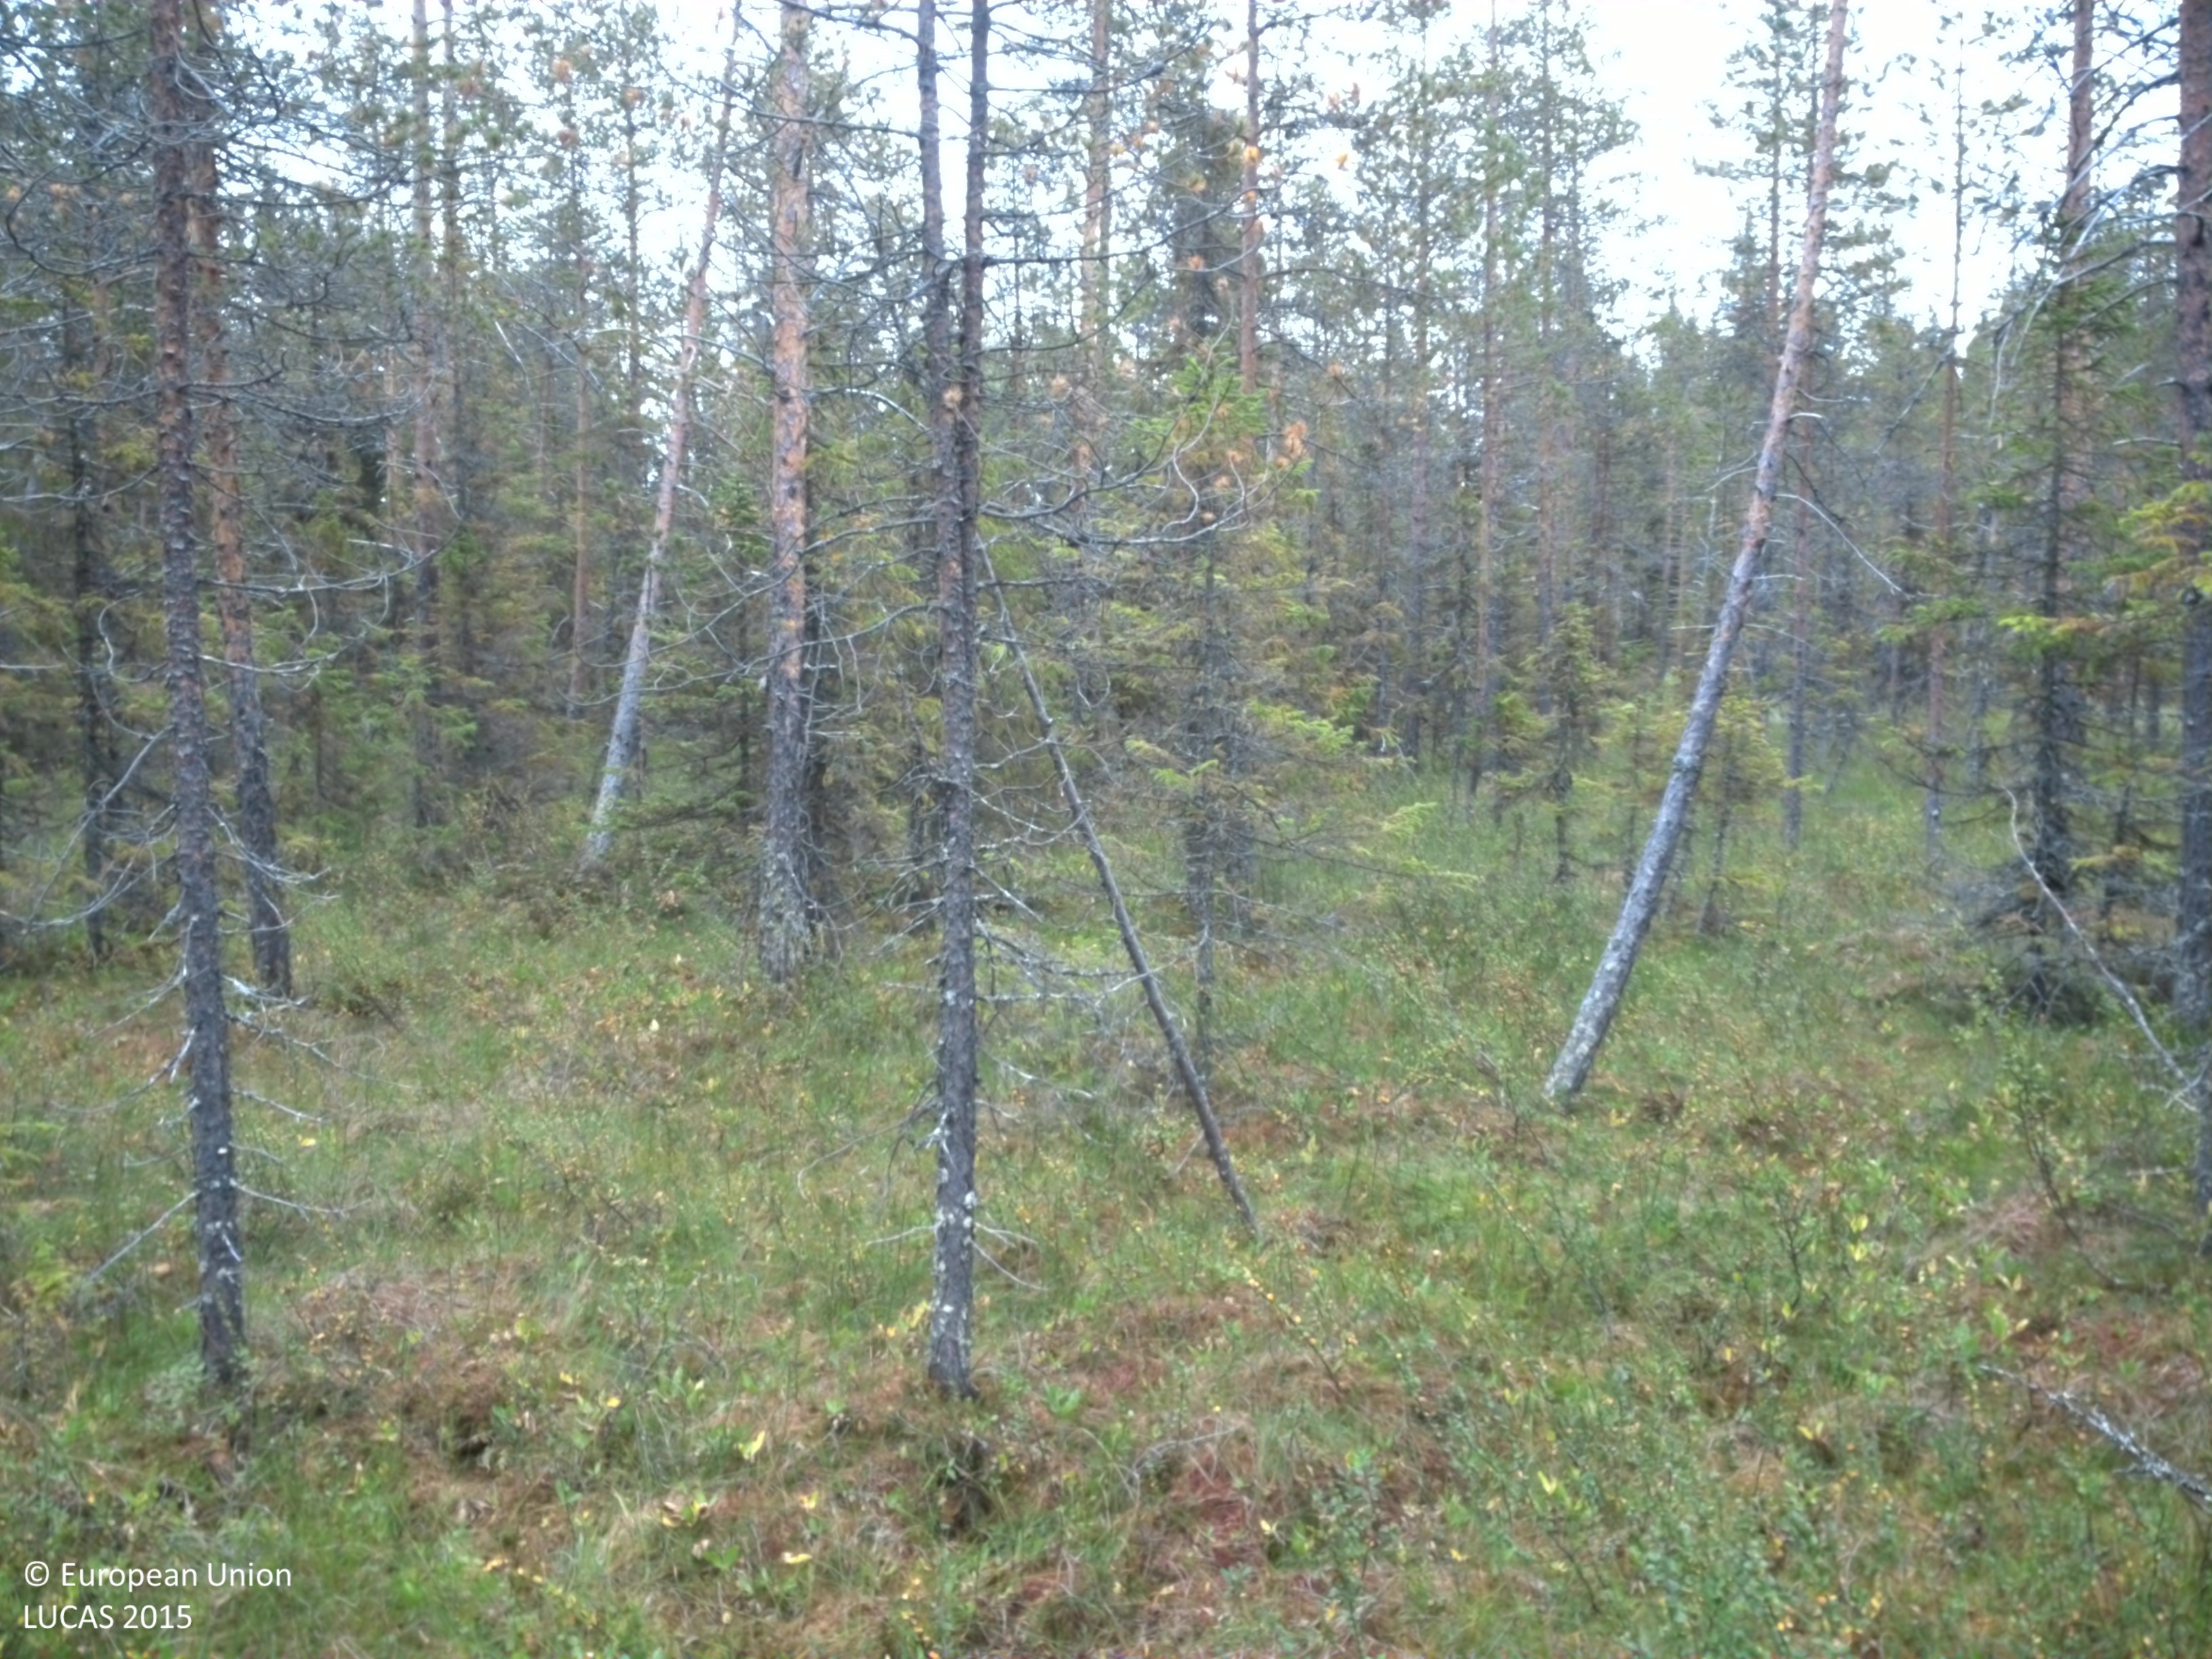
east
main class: Woodland
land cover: Pine dominated coniferous woodland
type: mire and swamp forests
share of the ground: 10 - 25 %
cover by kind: lichens and mosses 35 %, herbaceous plants 30 %, coniferous forest trees 20 %, shrubs 15 %
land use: Semi-natural and natural areas not in use
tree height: > 5 m
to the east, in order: Pine dominated coniferous woodland; Spruce dominated mixed woodland; Ditches and canals; Spruce dominated mixed woodland; Pine dominated coniferous woodland; Ditches and canals; Pine dominated coniferous woodland; Peatbogs; Shrubland with sparse tree cover; Ditches and canals
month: August
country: SE
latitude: 64.7476
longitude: 16.6678
